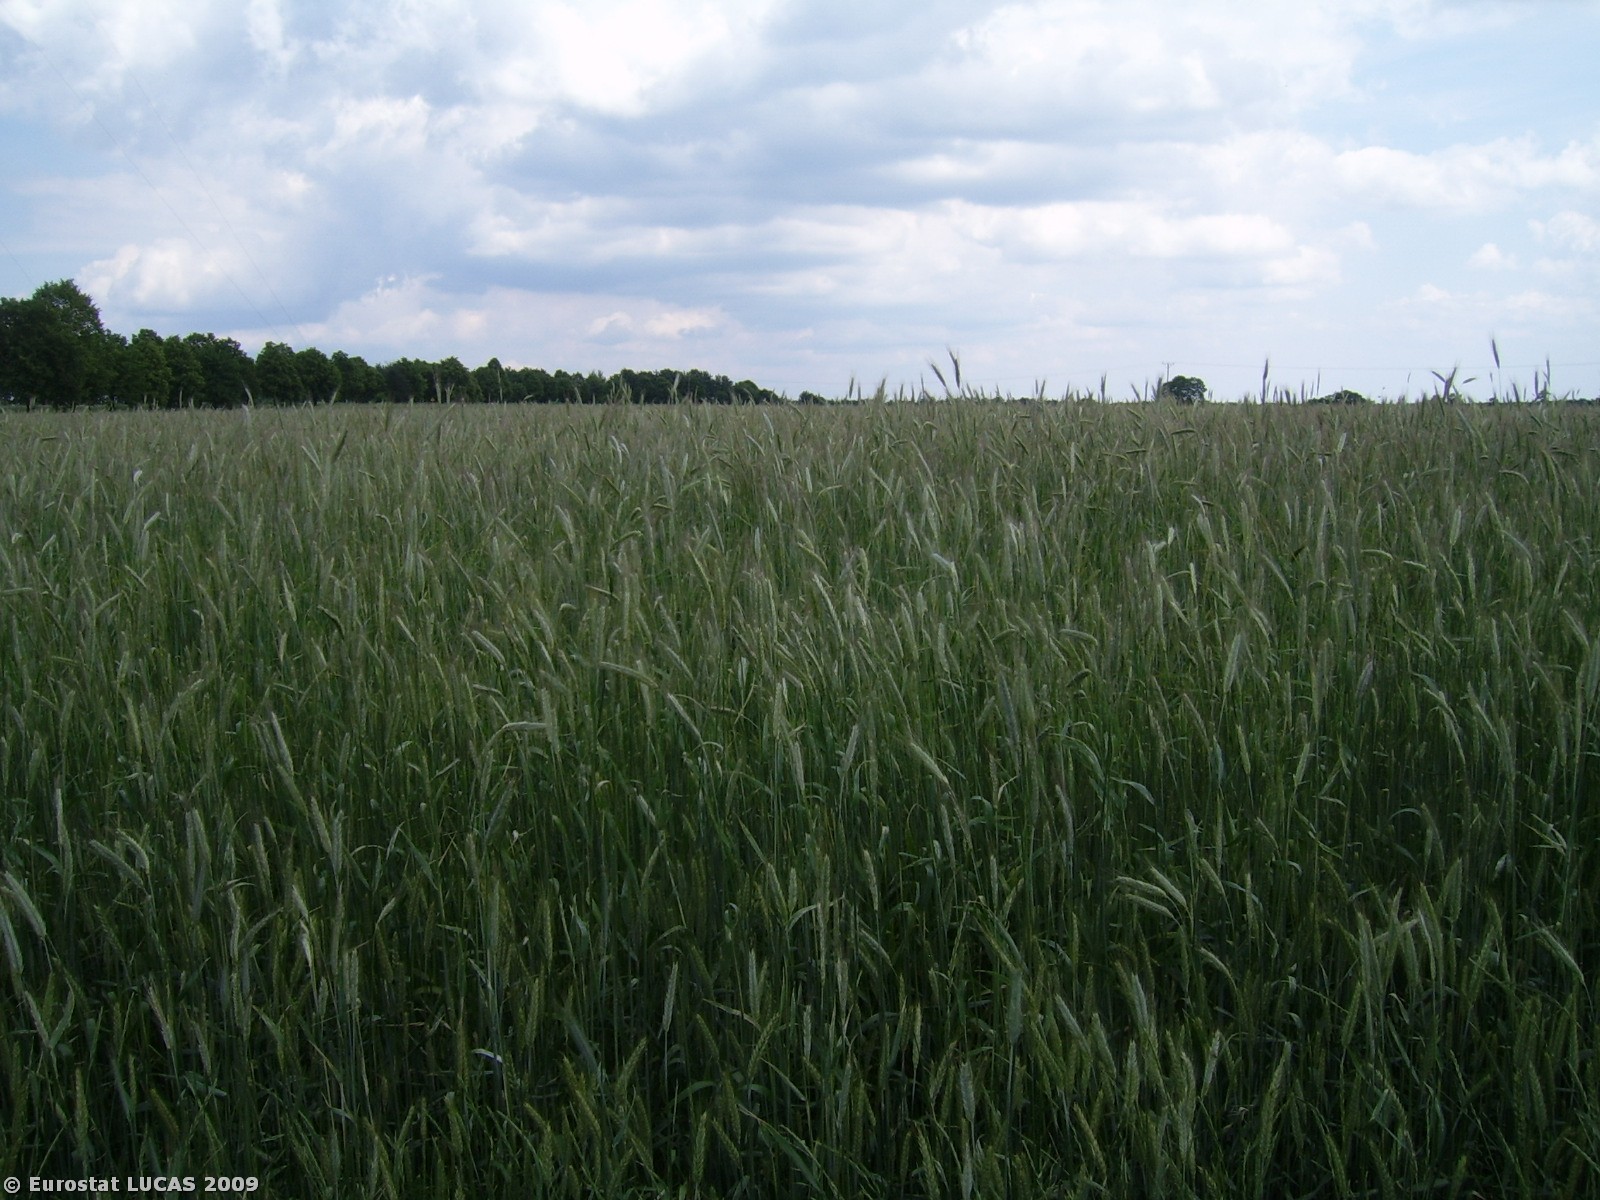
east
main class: Grassland
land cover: Grassland without tree/shrub cover
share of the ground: > 75 %
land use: Agriculture (excluding fallow land and kitchen gardens)
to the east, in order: Grassland without tree/shrub cover; Fences; Triticale; Maize; Grass margins; Rice
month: June
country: PL
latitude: 51.5300
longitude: 17.9873
